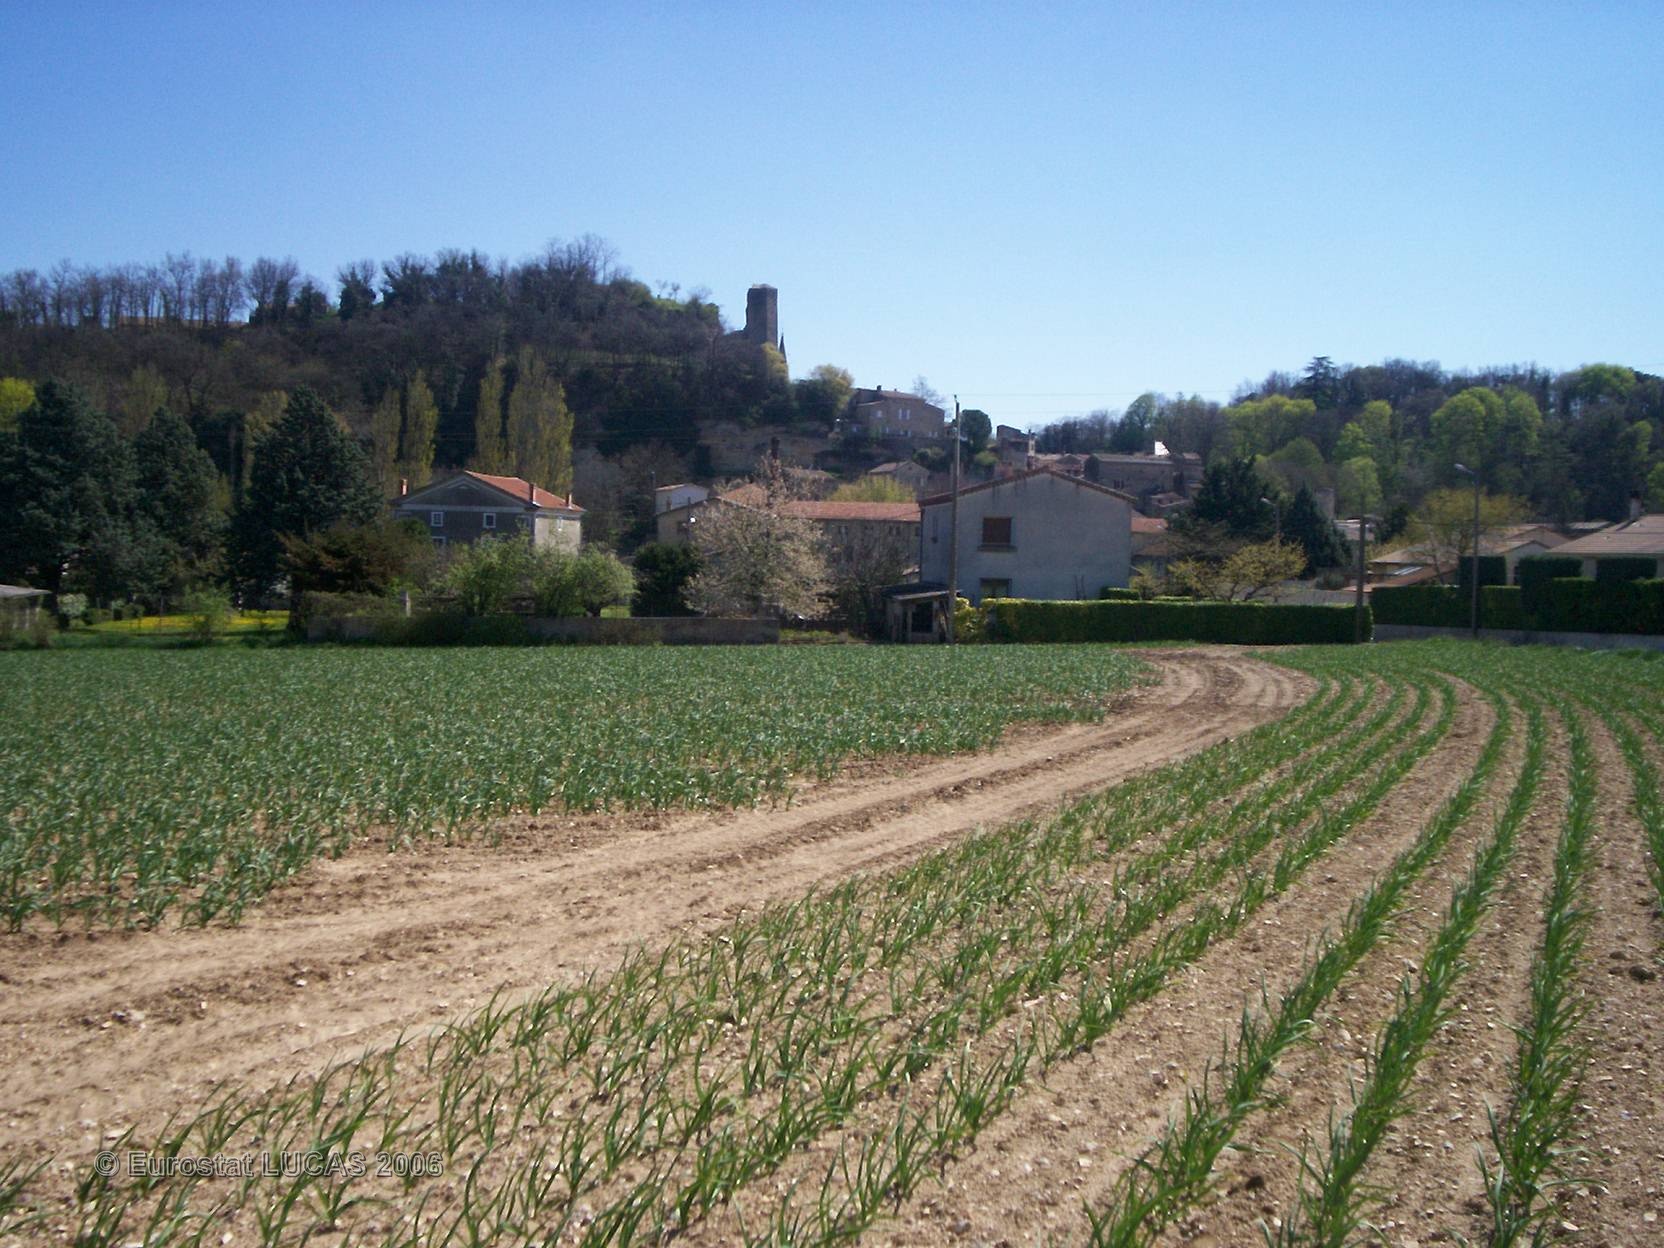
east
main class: Cropland
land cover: Other fresh vegetables
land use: Agriculture (excluding fallow land and kitchen gardens)
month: April
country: FR
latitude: 44.7319
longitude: 4.9176
